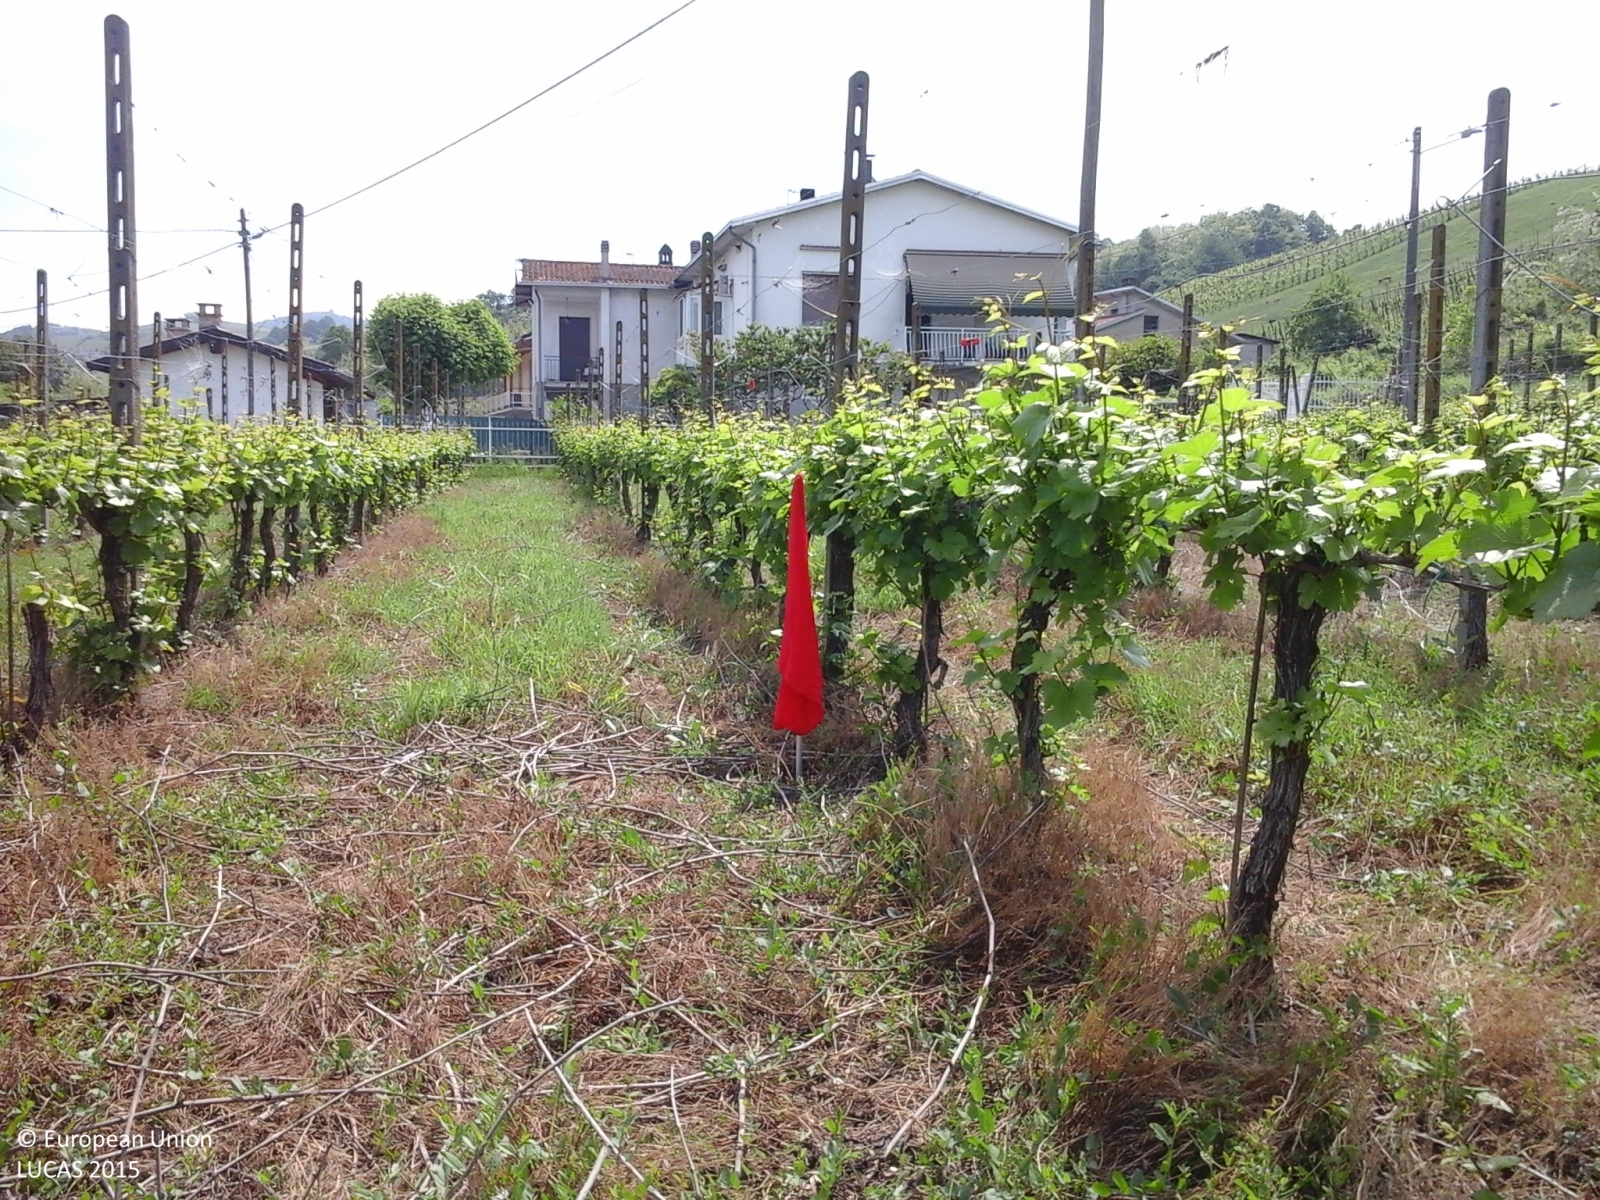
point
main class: Cropland
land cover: Vineyards
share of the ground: 50 - 75 %
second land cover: Grassland without tree/shrub cover
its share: > 75 %
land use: Agriculture (excluding fallow land and kitchen gardens)
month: May
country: IT
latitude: 45.0145
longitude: 9.1768
